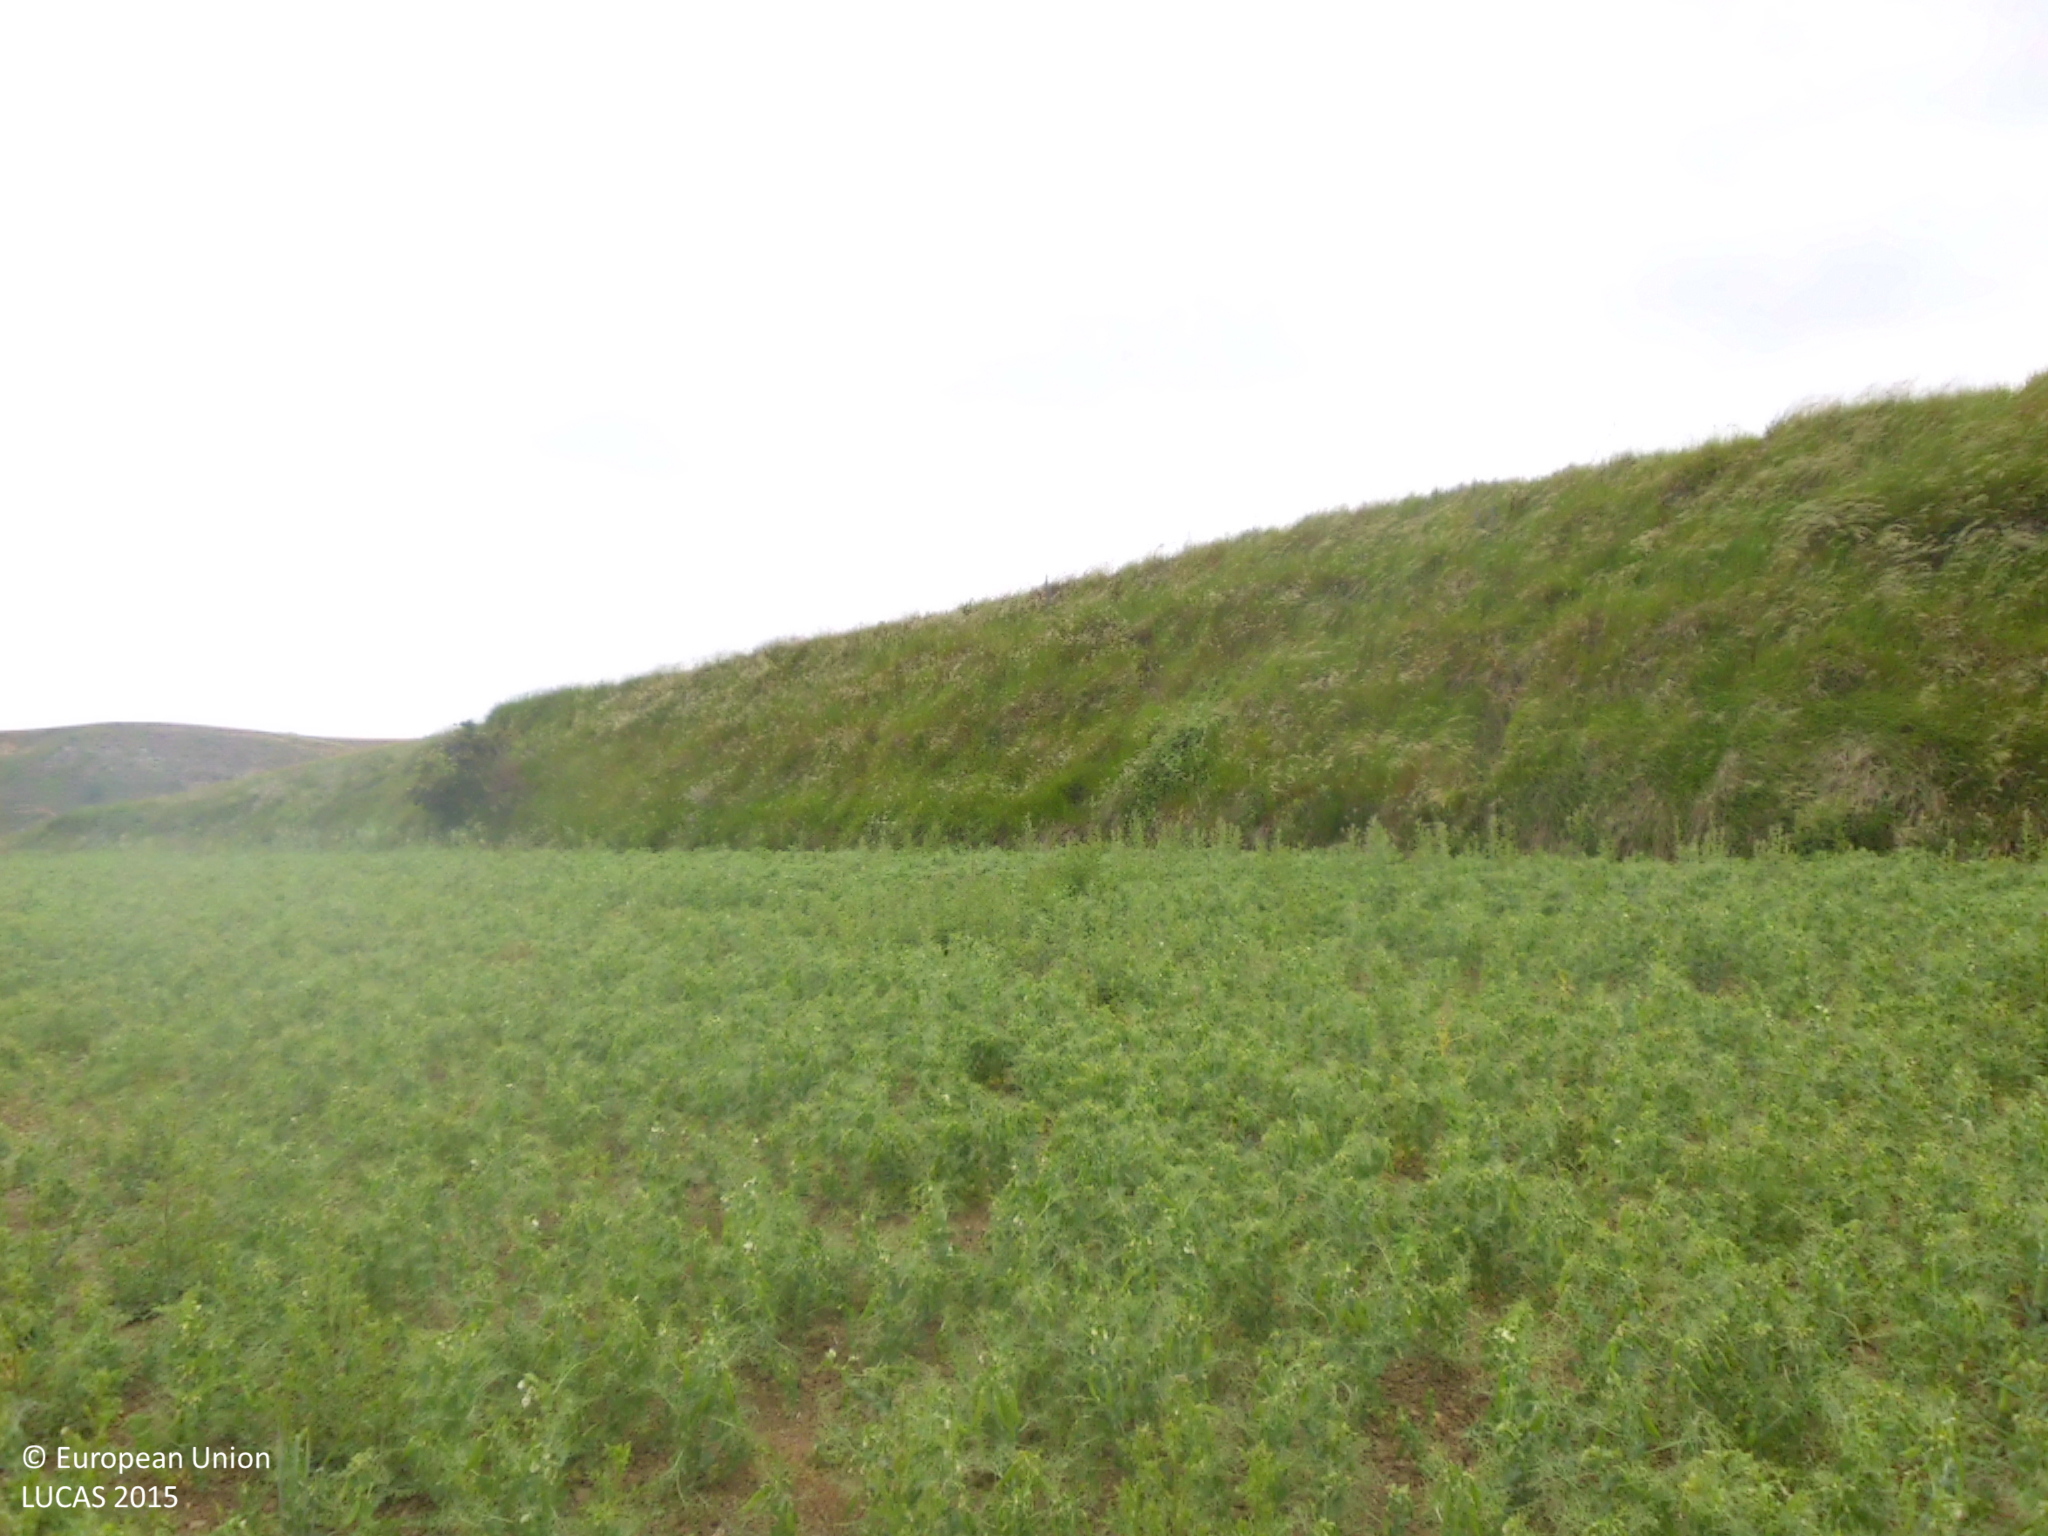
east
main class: Cropland
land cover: Dry pulses
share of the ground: > 75 %
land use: Agriculture (excluding fallow land and kitchen gardens)
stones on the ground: < 10 %
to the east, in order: Dry pulses; Grassland without tree/shrub cover; Barley; Grassland without tree/shrub cover; Common wheat; Grassland without tree/shrub cover
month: June
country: ES
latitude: 42.4993
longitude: -3.3325
